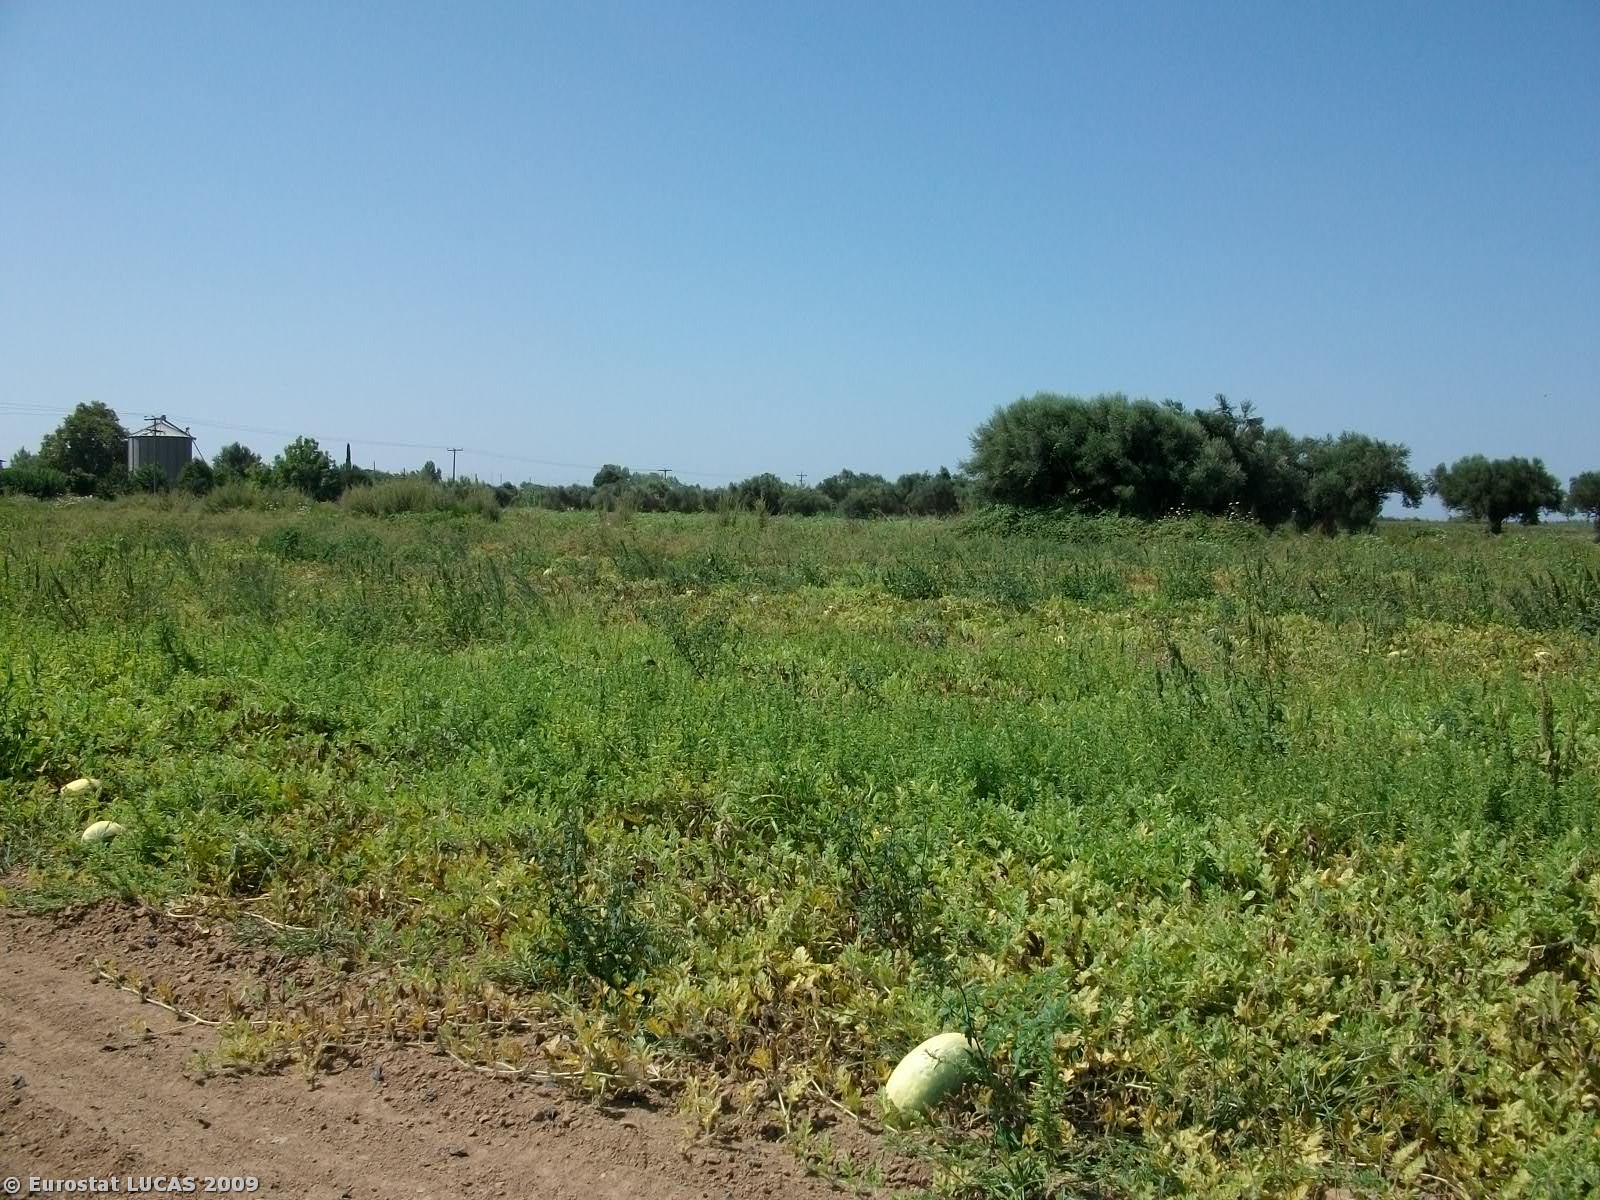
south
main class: Cropland
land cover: Other fresh vegetables
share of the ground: 50 - 75 %
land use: Agriculture (excluding fallow land and kitchen gardens)
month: July
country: GR
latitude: 38.0179
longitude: 21.3418
